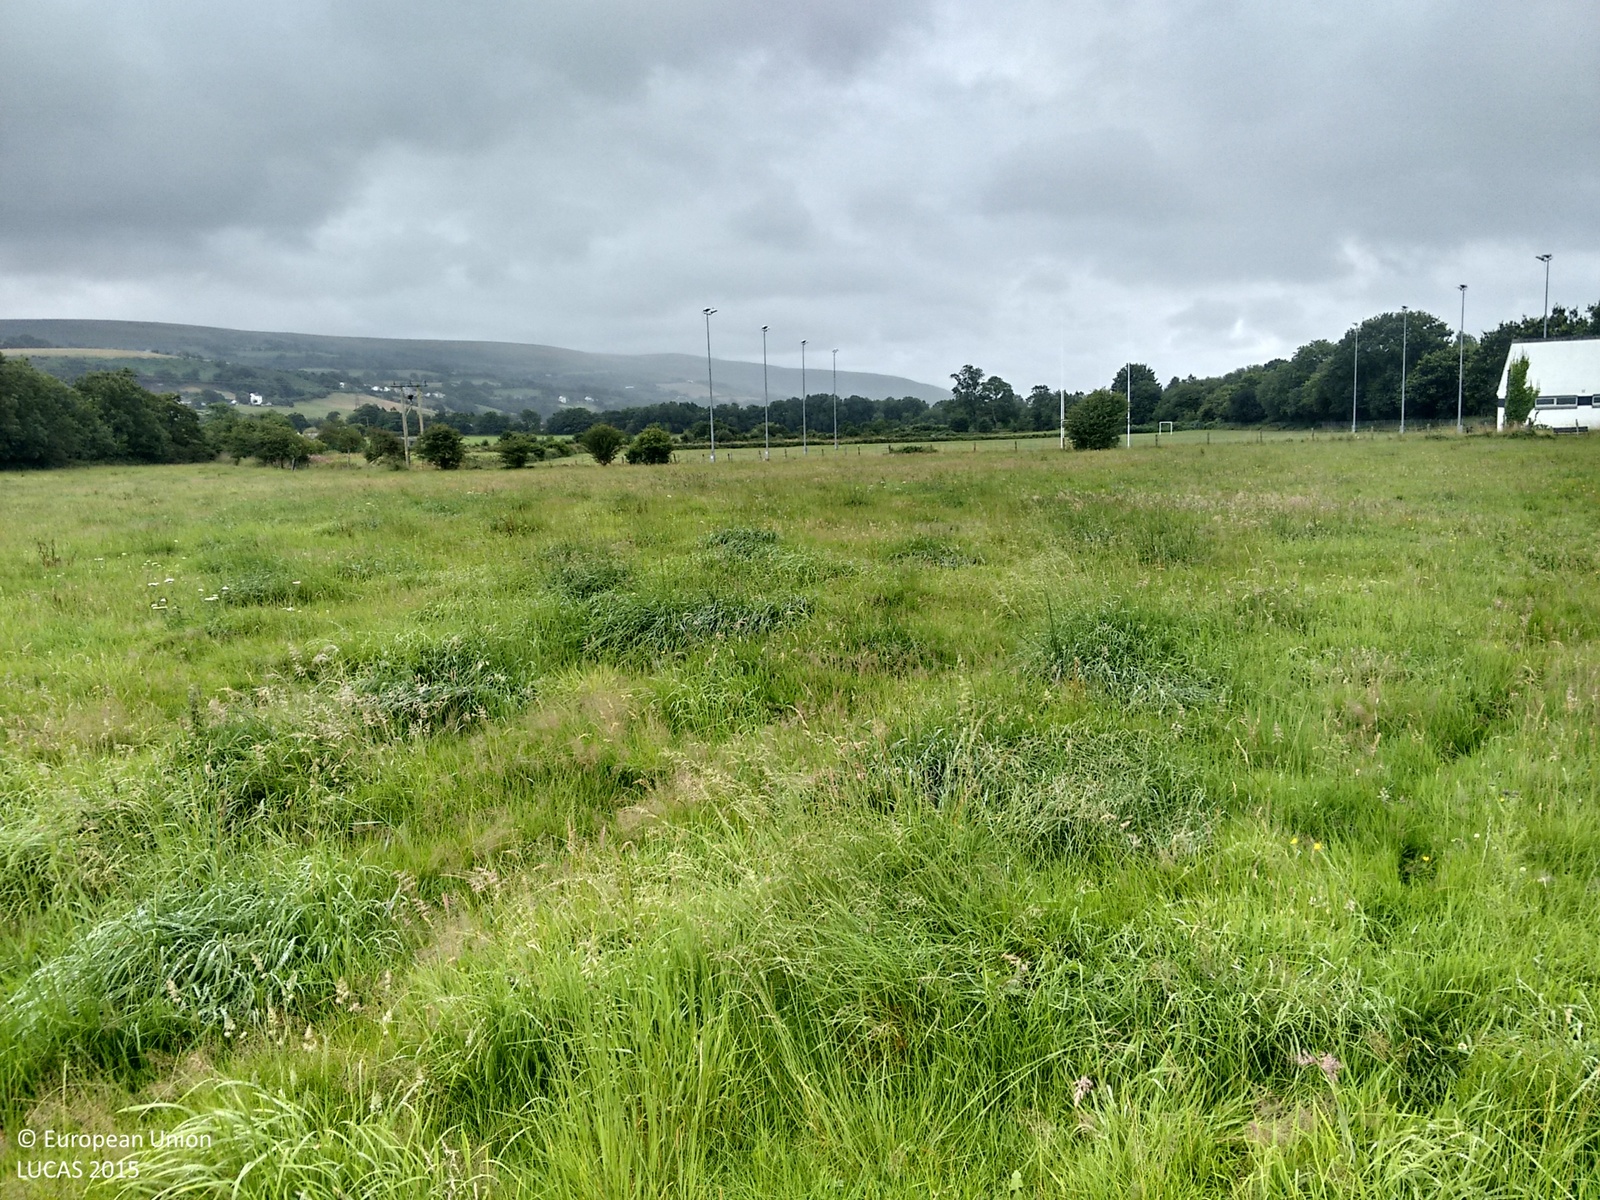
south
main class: Grassland
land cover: Grassland without tree/shrub cover
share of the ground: > 75 %
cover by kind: herbaceous plants 100 %
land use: Agriculture (excluding fallow land and kitchen gardens)
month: July
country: GB
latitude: 51.7803
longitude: -3.9950
